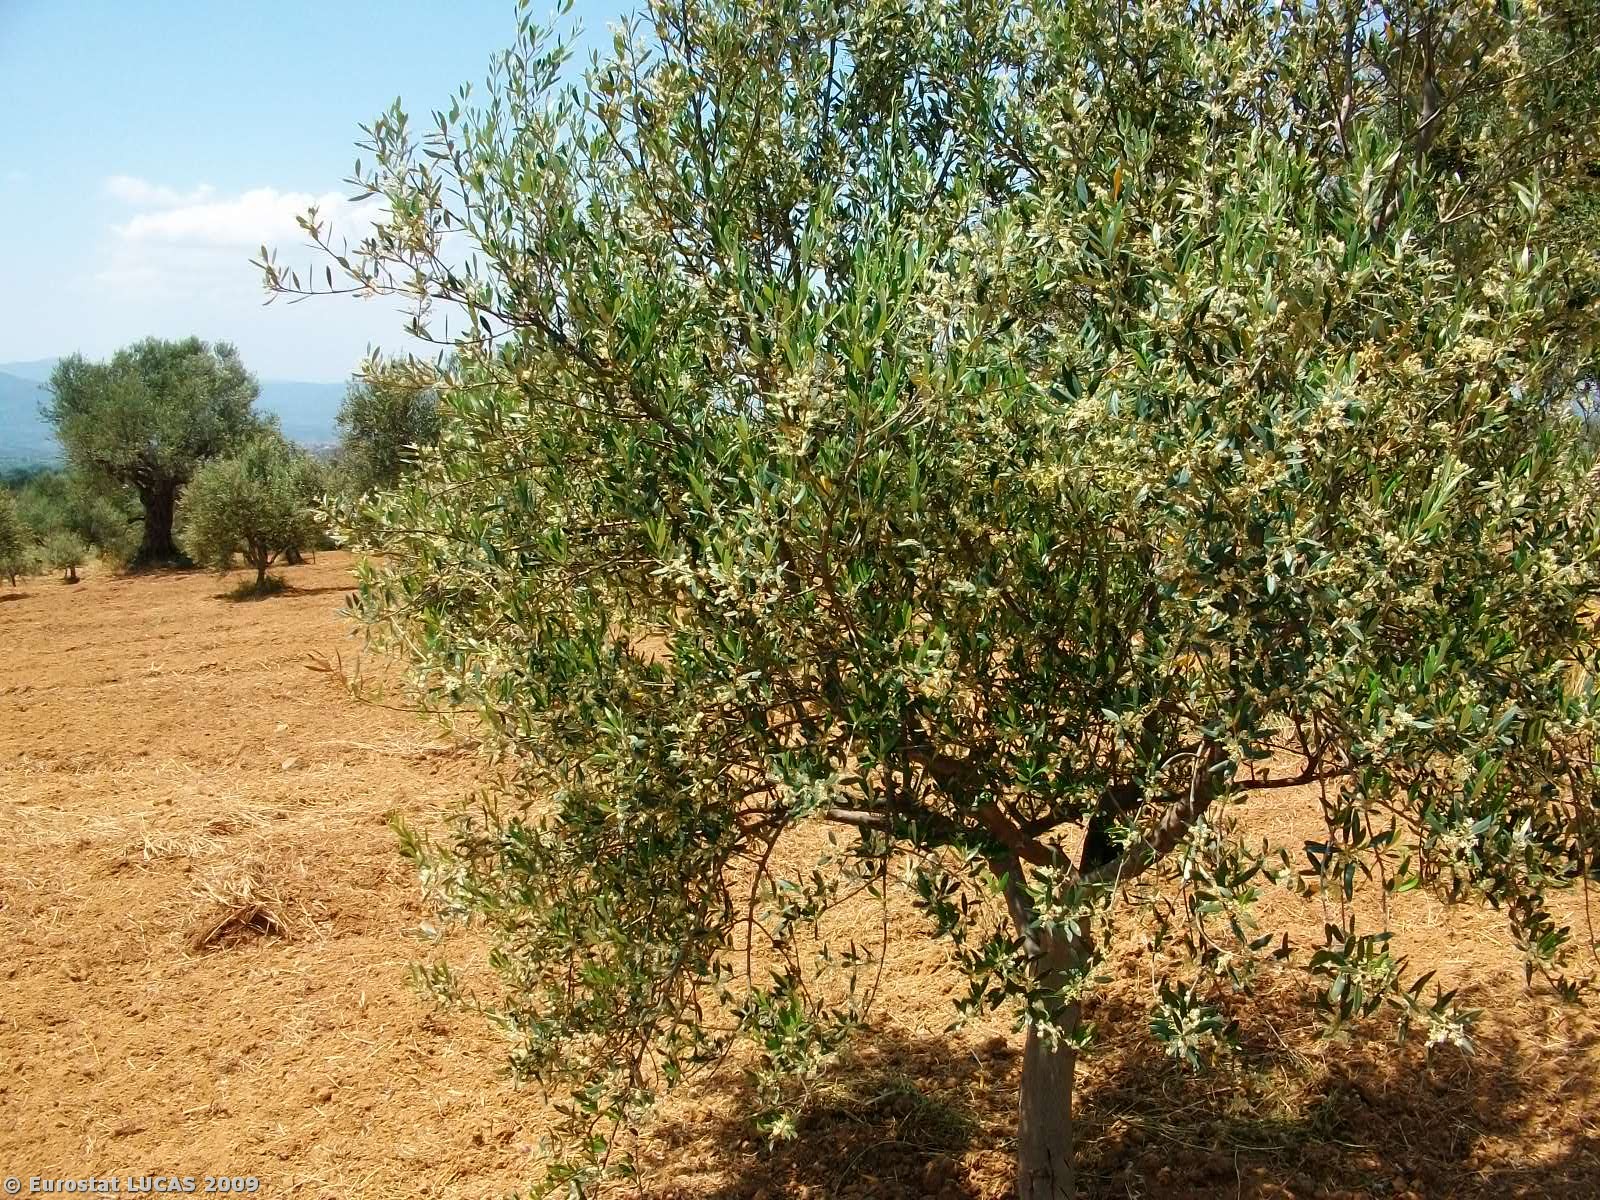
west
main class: Cropland
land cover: Olive groves
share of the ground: 25 - 50 %
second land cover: Bare land
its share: > 75 %
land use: Agriculture (excluding fallow land and kitchen gardens)
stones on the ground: < 10 %
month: May
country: GR
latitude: 37.2375
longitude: 22.0284
